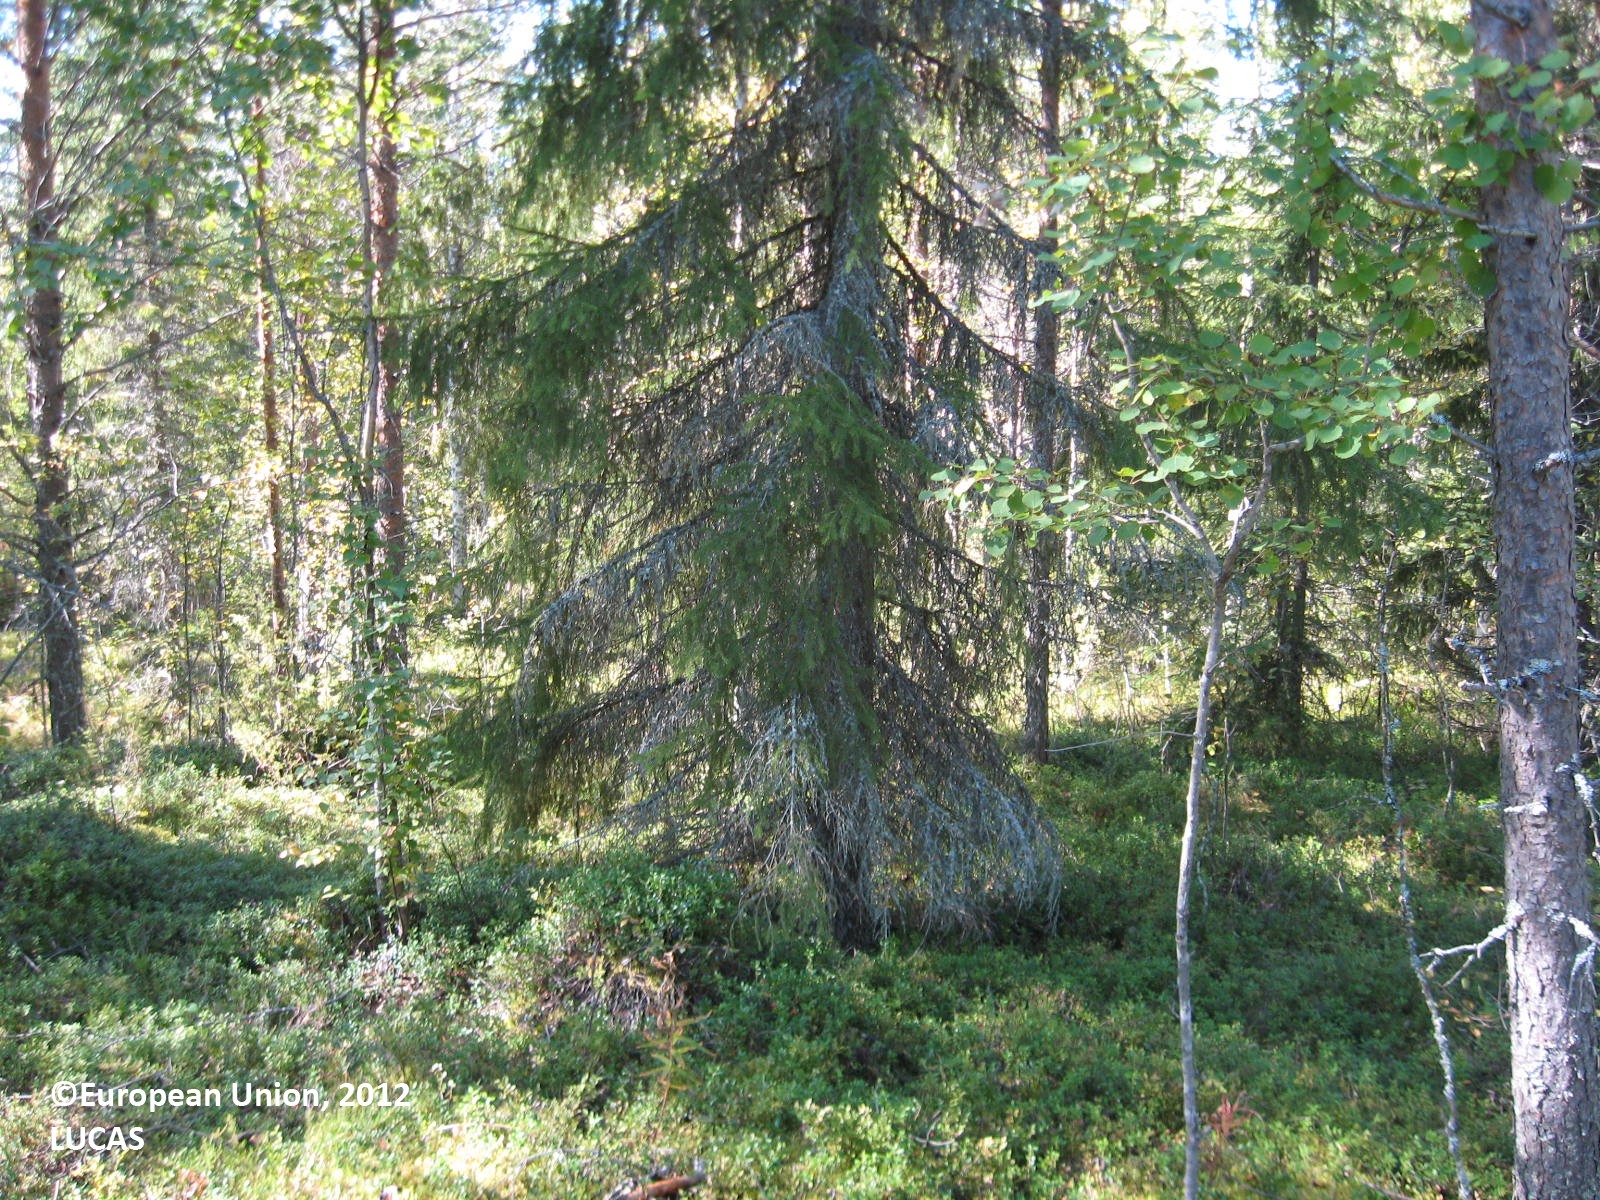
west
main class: Woodland
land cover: Pine dominated mixed woodland
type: boreal forest
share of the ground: > 75 %
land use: Forestry
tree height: > 5 m
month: August
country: FI
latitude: 63.8378
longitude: 29.3877
